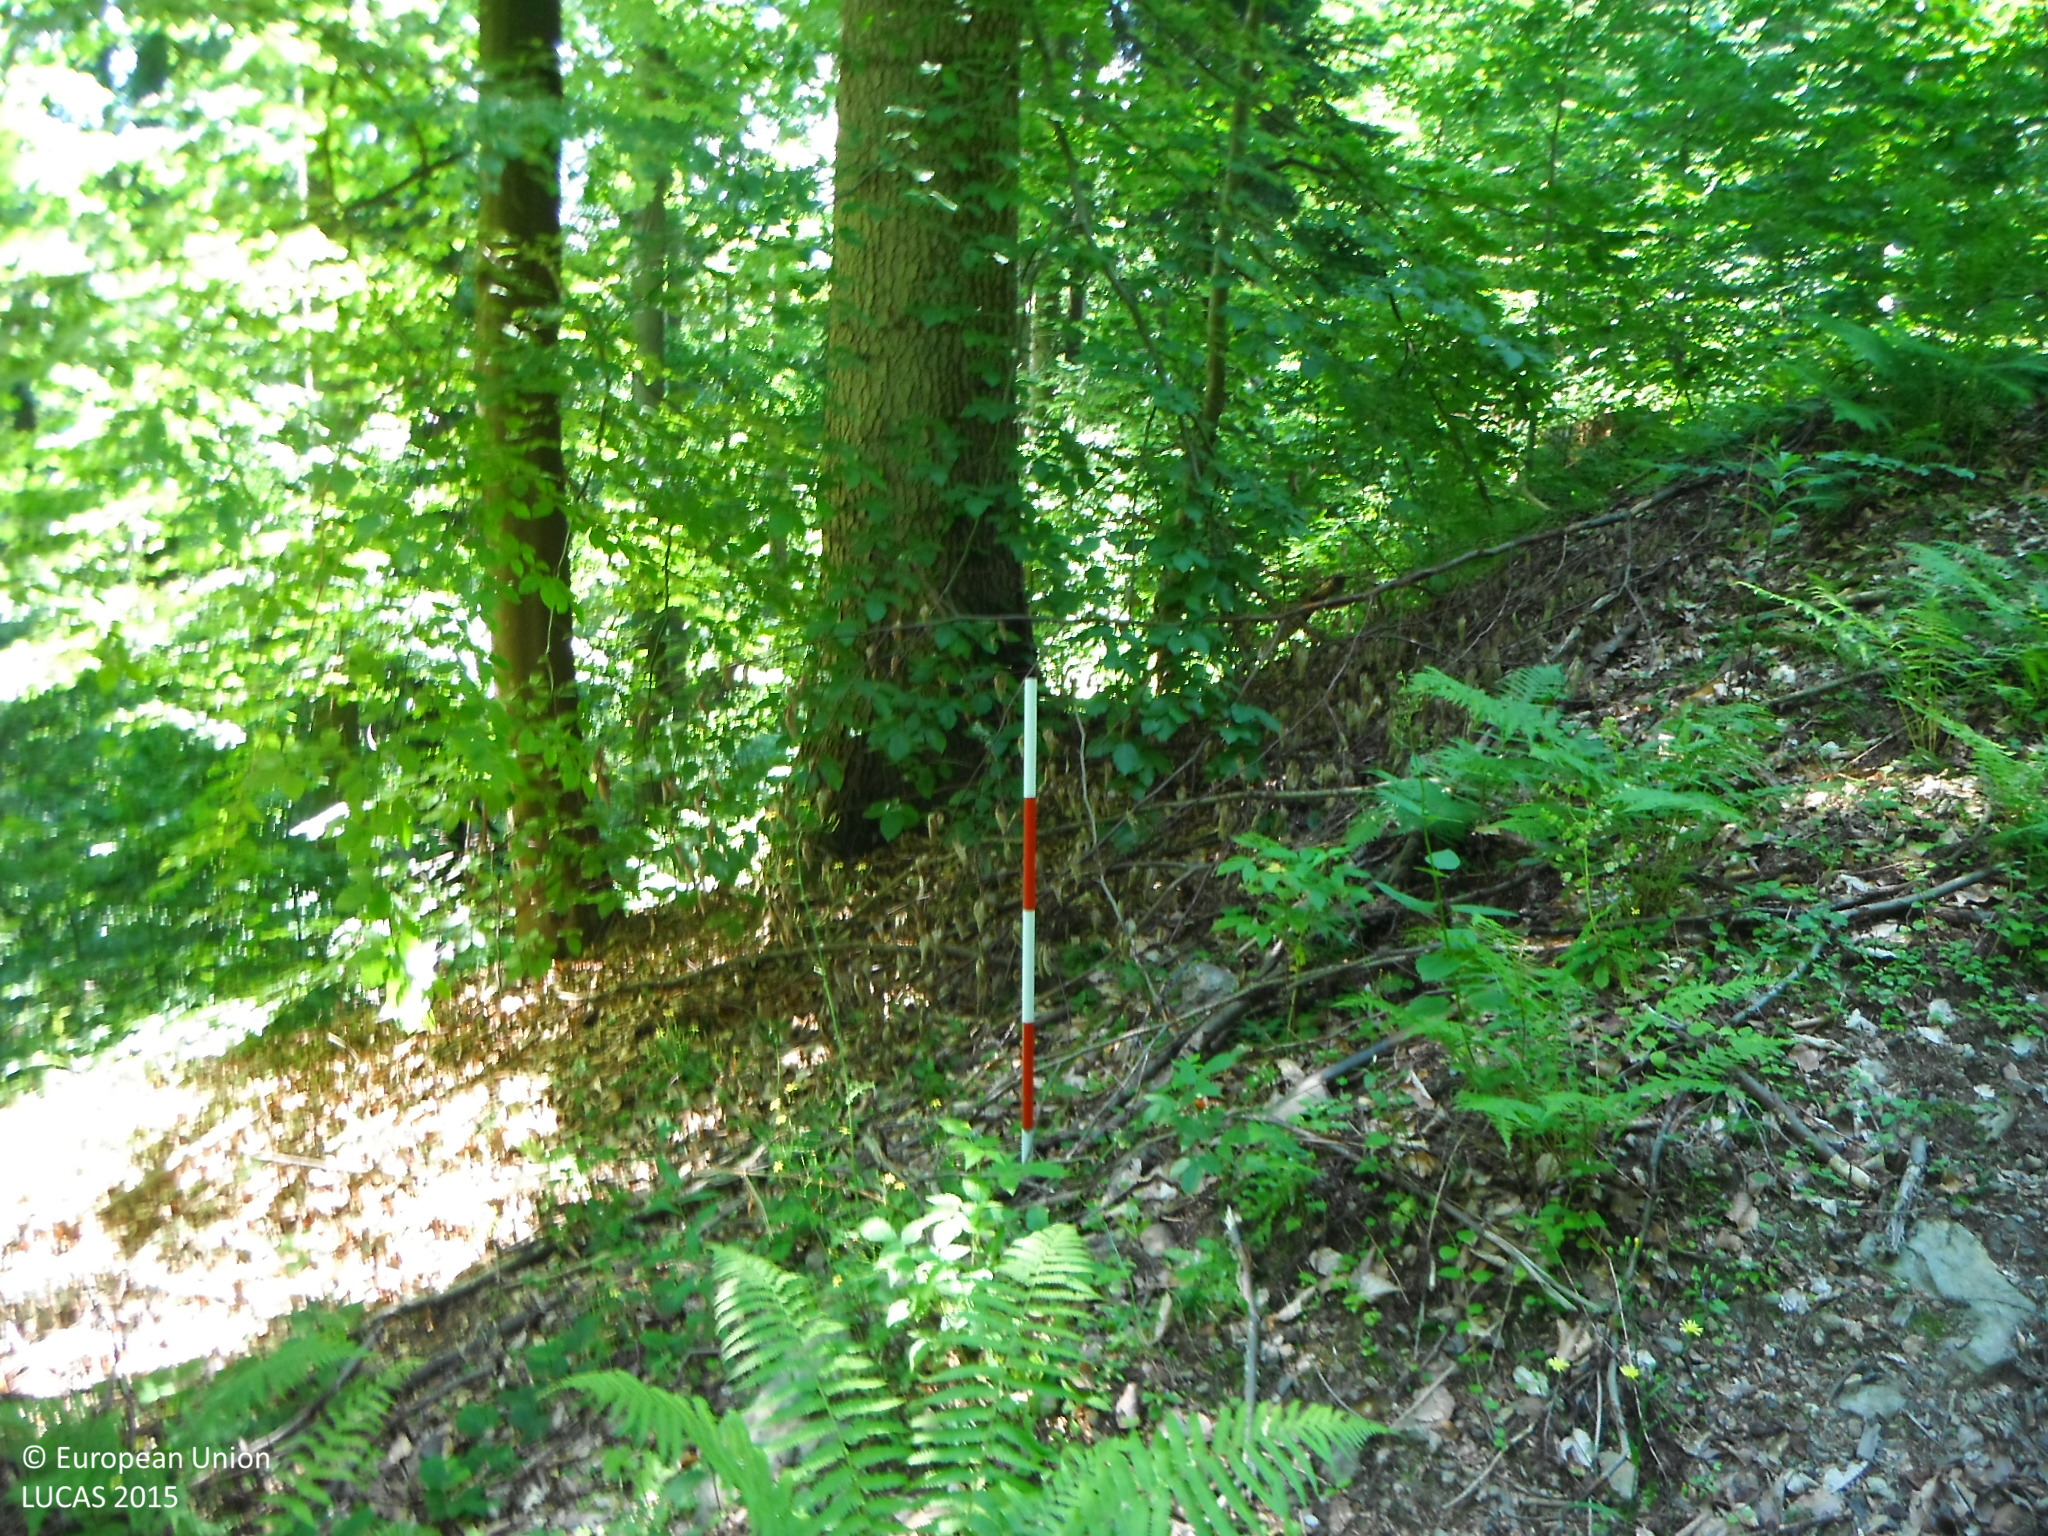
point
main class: Woodland
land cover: Other mixed woodland
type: hemiboreal forest and nemoral coniferous forest and mixed broadleaved-coniferous forest
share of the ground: > 75 %
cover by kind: coniferous forest trees 50 %, broadleaved forest trees 50 %
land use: Forestry
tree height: > 5 m
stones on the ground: > 50 %
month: July
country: SK
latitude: 48.8379
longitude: 20.9543
